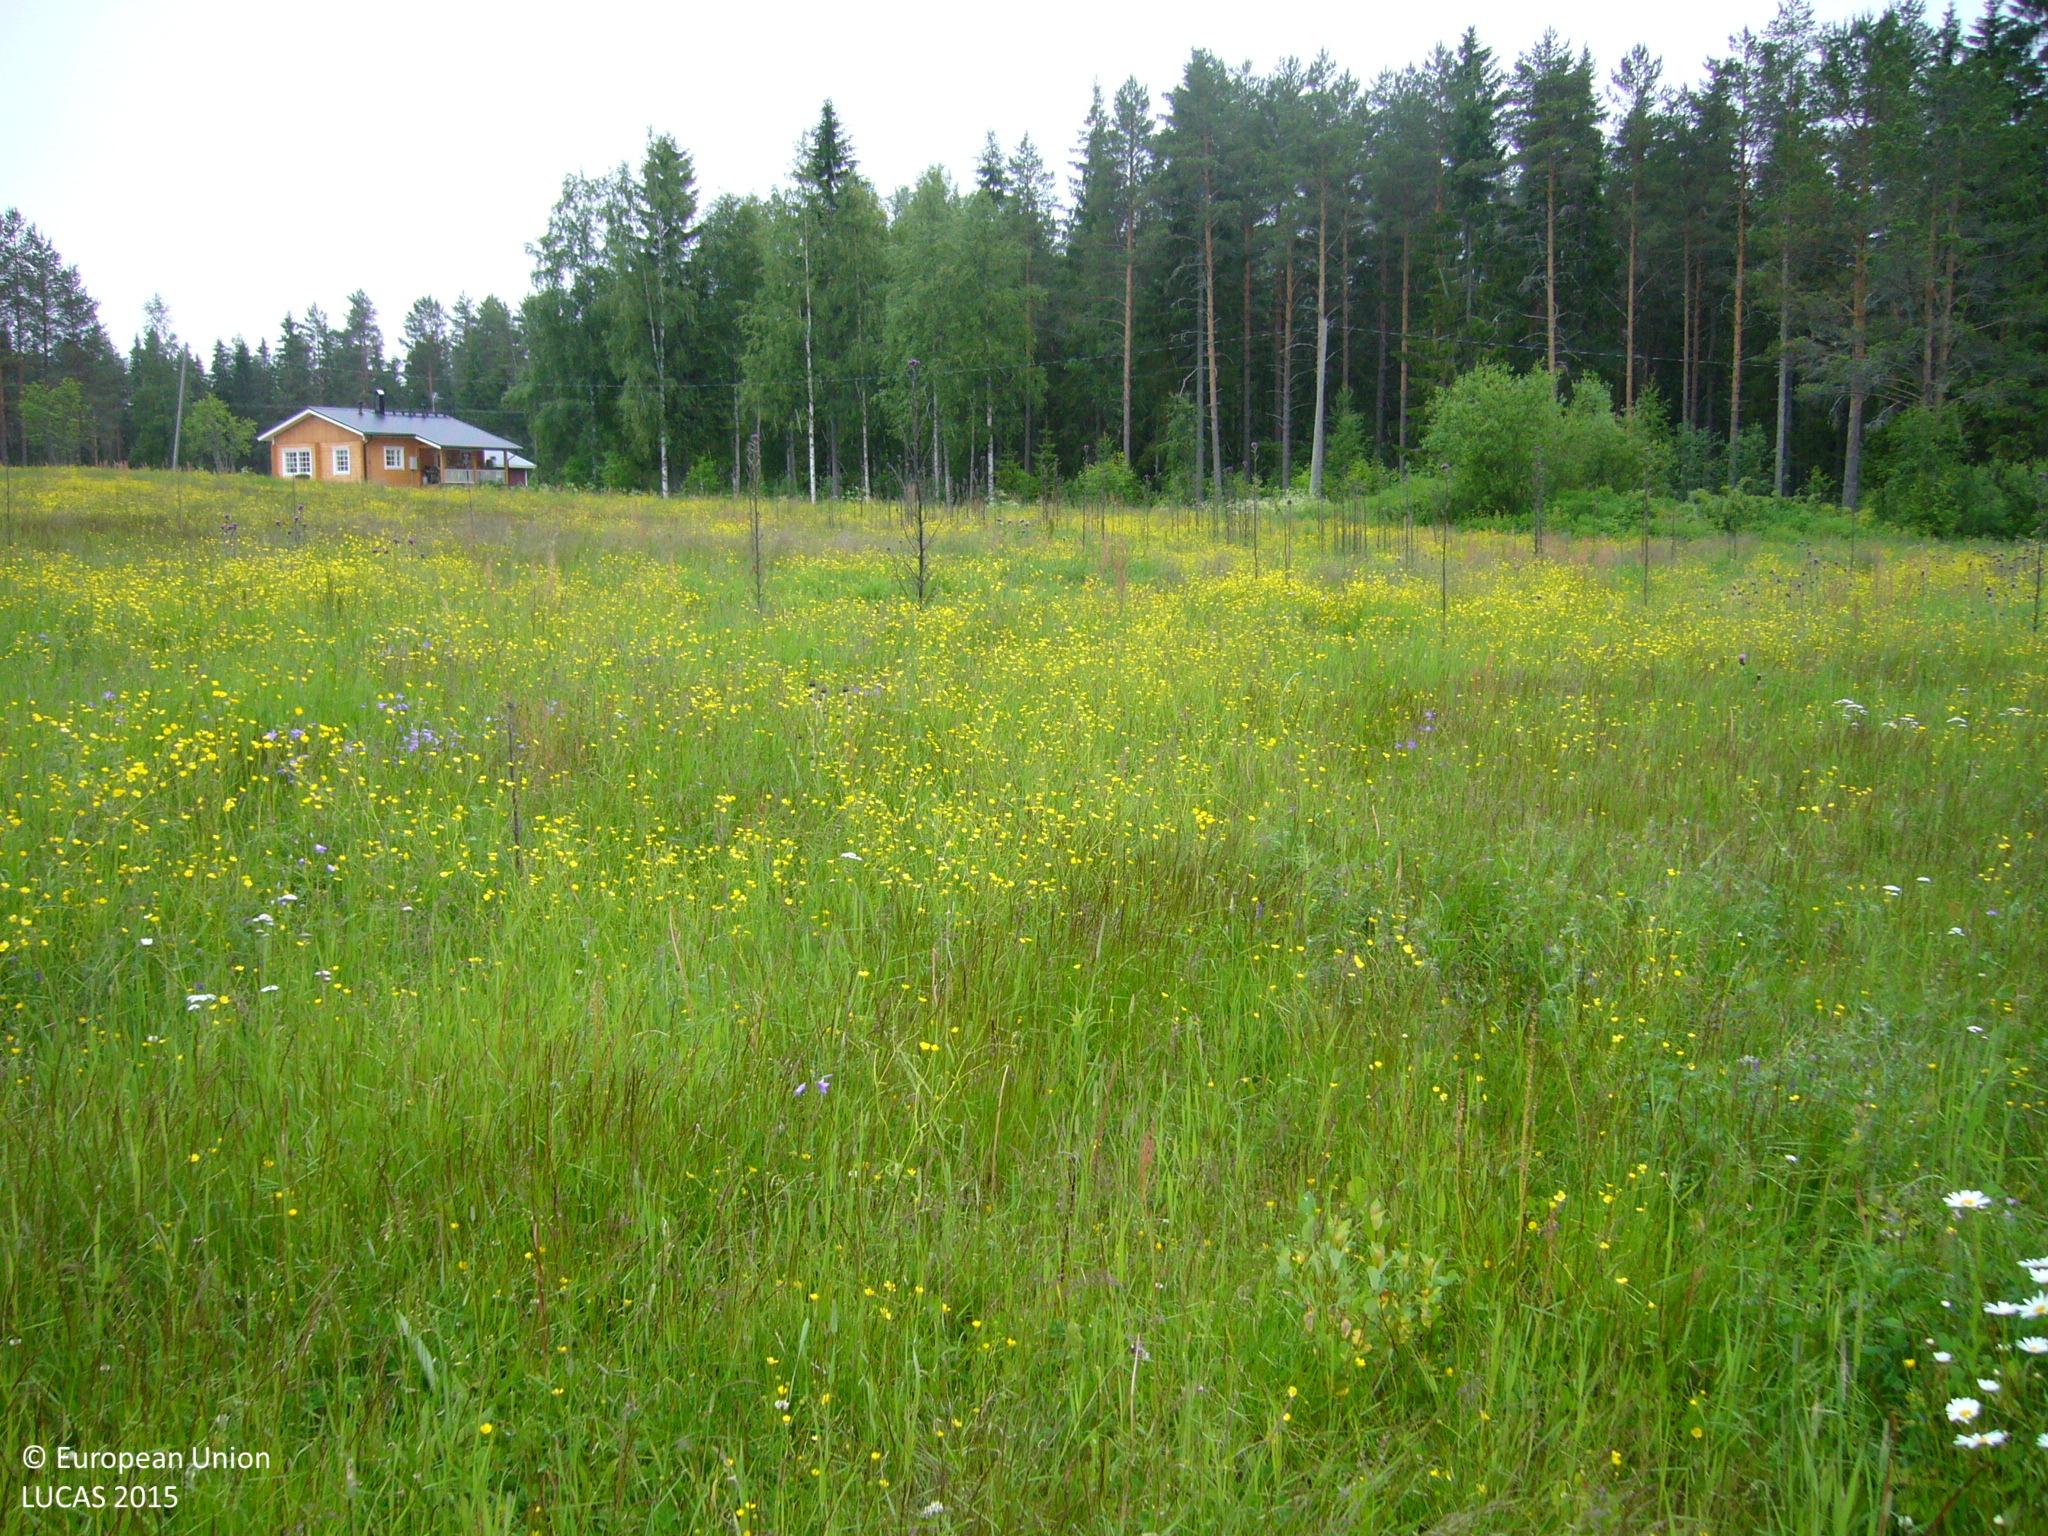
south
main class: Grassland
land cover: Grassland without tree/shrub cover
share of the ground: > 75 %
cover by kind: herbaceous plants 100 %
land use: Agriculture (excluding fallow land and kitchen gardens)
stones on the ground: < 10 %
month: July
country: FI
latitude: 63.4581
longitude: 25.7329
